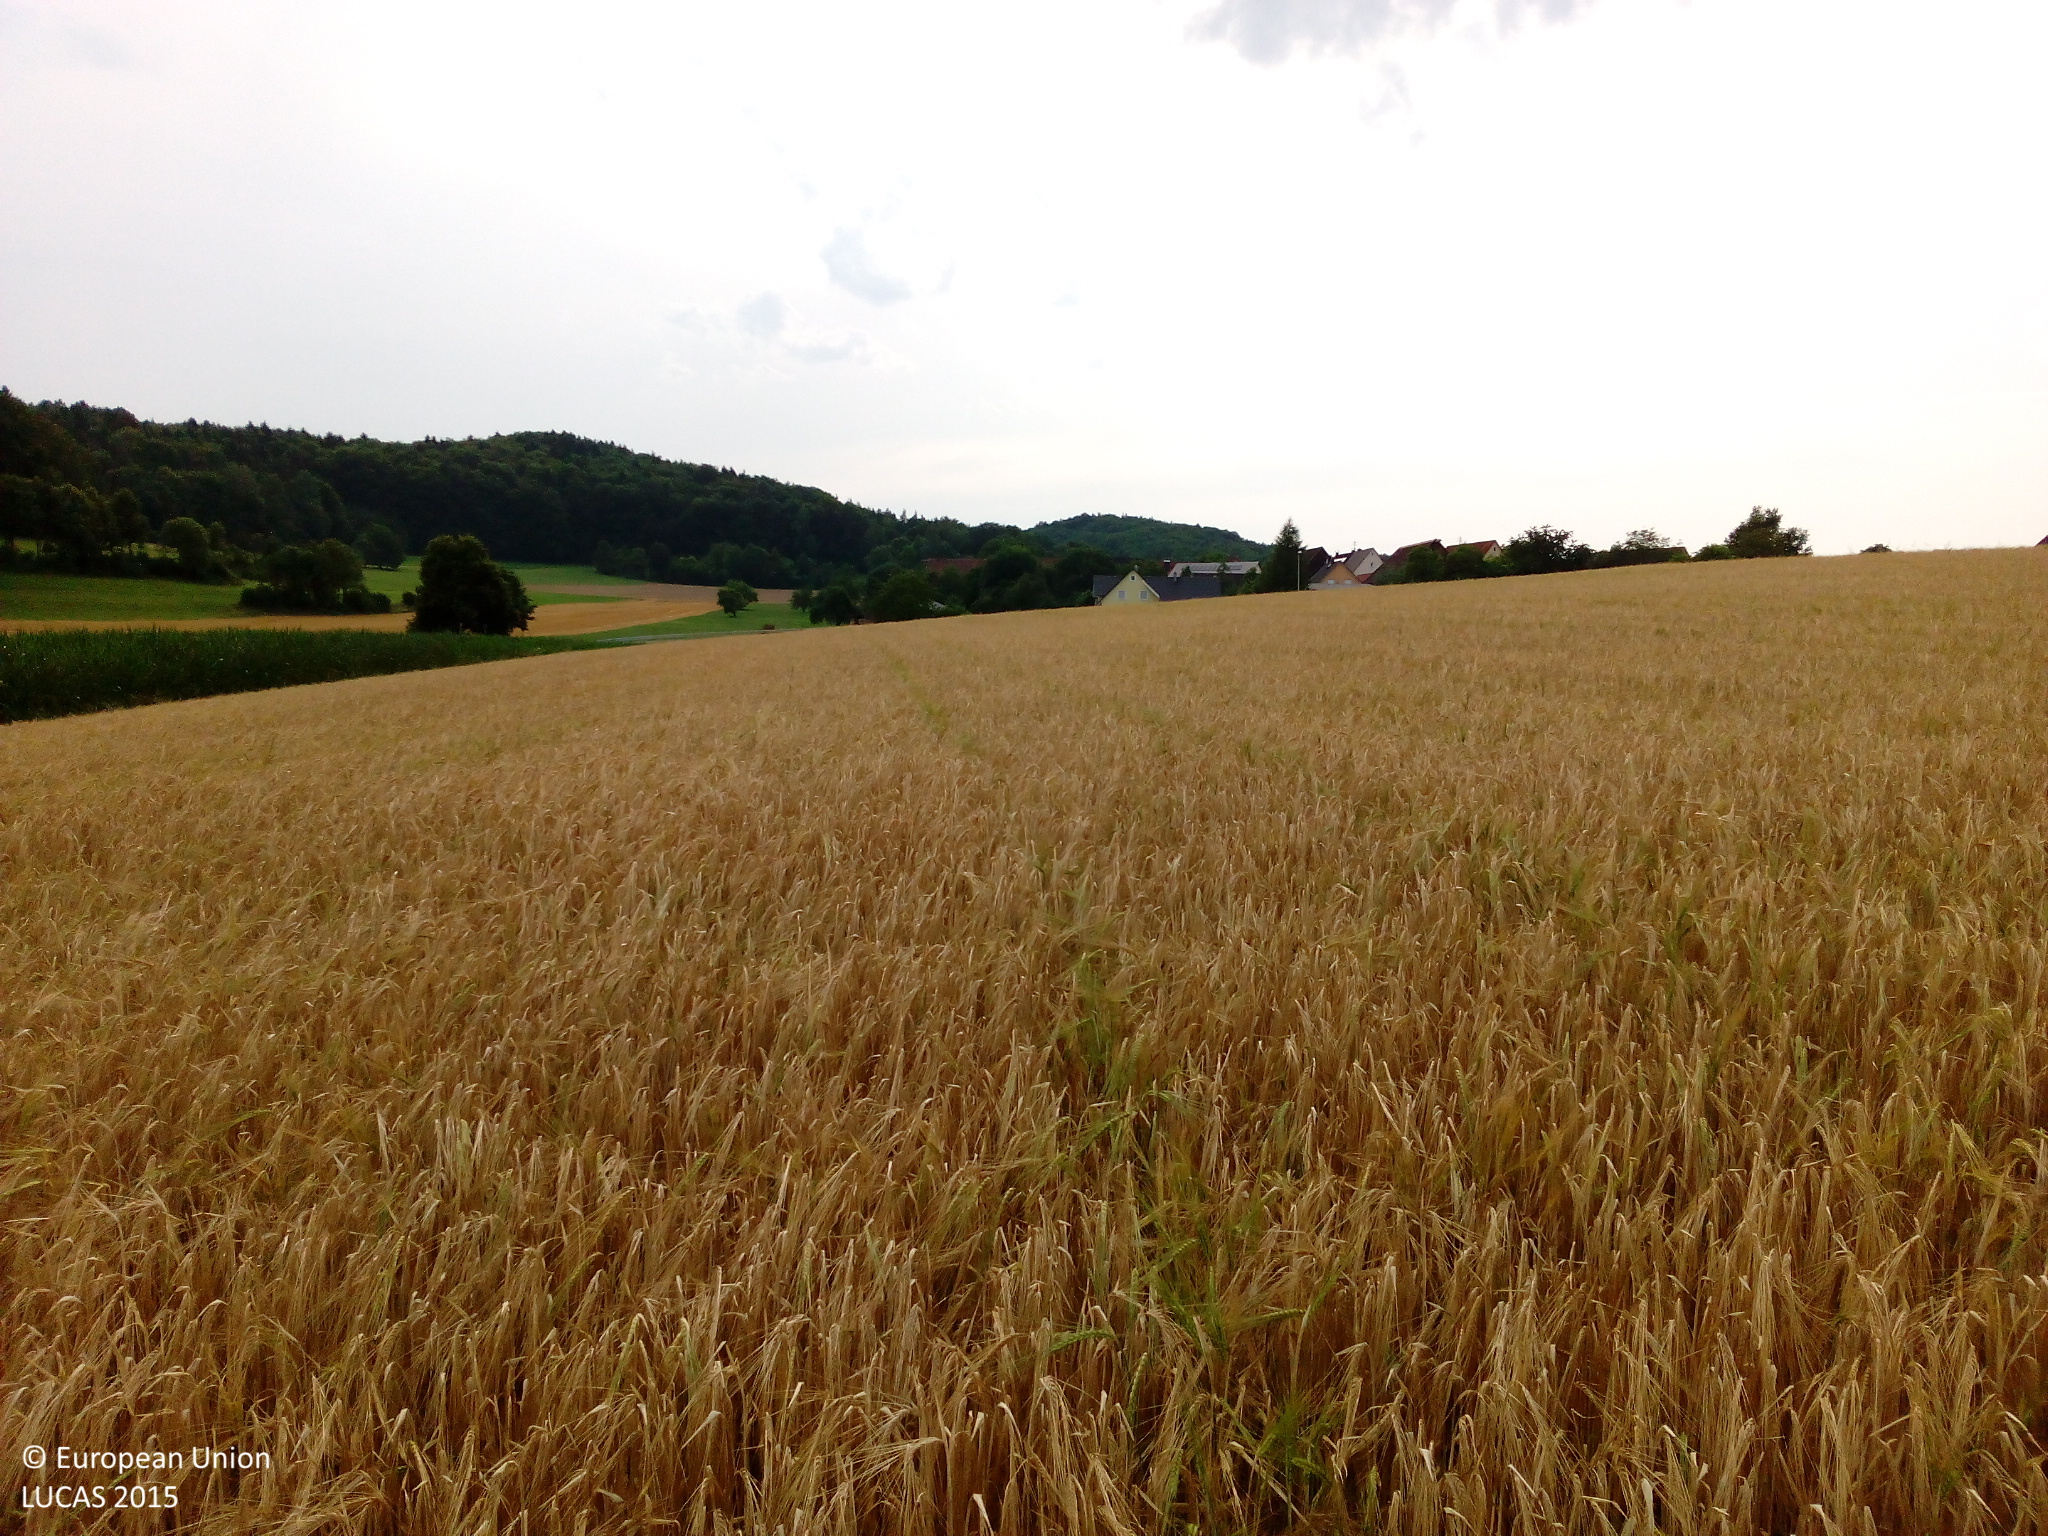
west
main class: Cropland
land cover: Barley
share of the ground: > 75 %
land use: Agriculture (excluding fallow land and kitchen gardens)
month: July
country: DE
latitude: 49.6350
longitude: 11.4811
